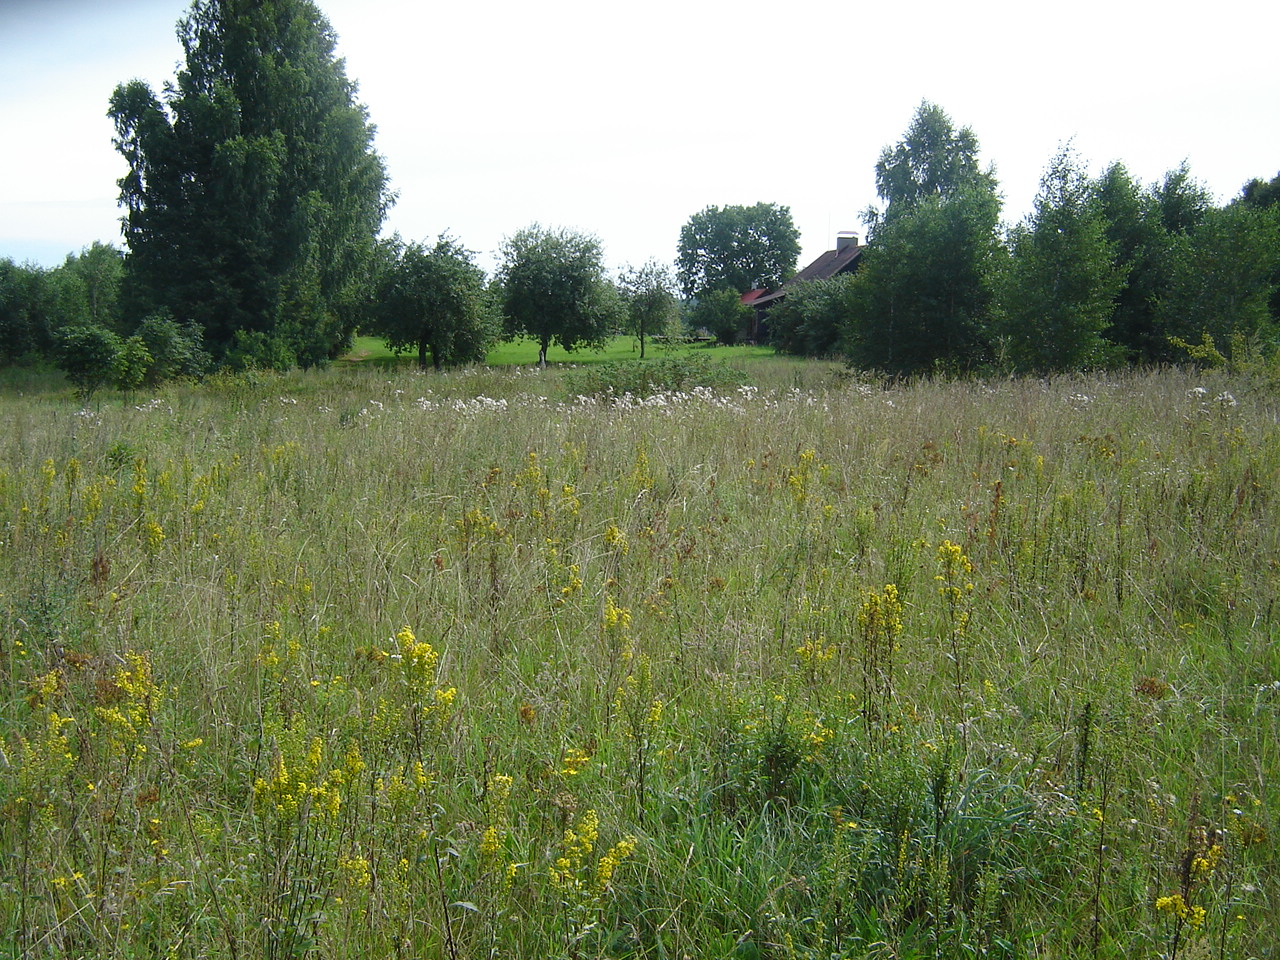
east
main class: Grassland
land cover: Grassland with sparse tree/shrub cover
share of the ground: > 75 %
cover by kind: herbaceous plants 90 %, broadleaved forest trees 5 %, shrubs 5 %
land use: Agriculture (excluding fallow land and kitchen gardens)
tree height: > 5 m
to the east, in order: Grassland with sparse tree/shrub cover; Artificial constructions in urban areas; Grassland without tree/shrub cover
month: August
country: LT
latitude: 54.9274
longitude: 24.8887
